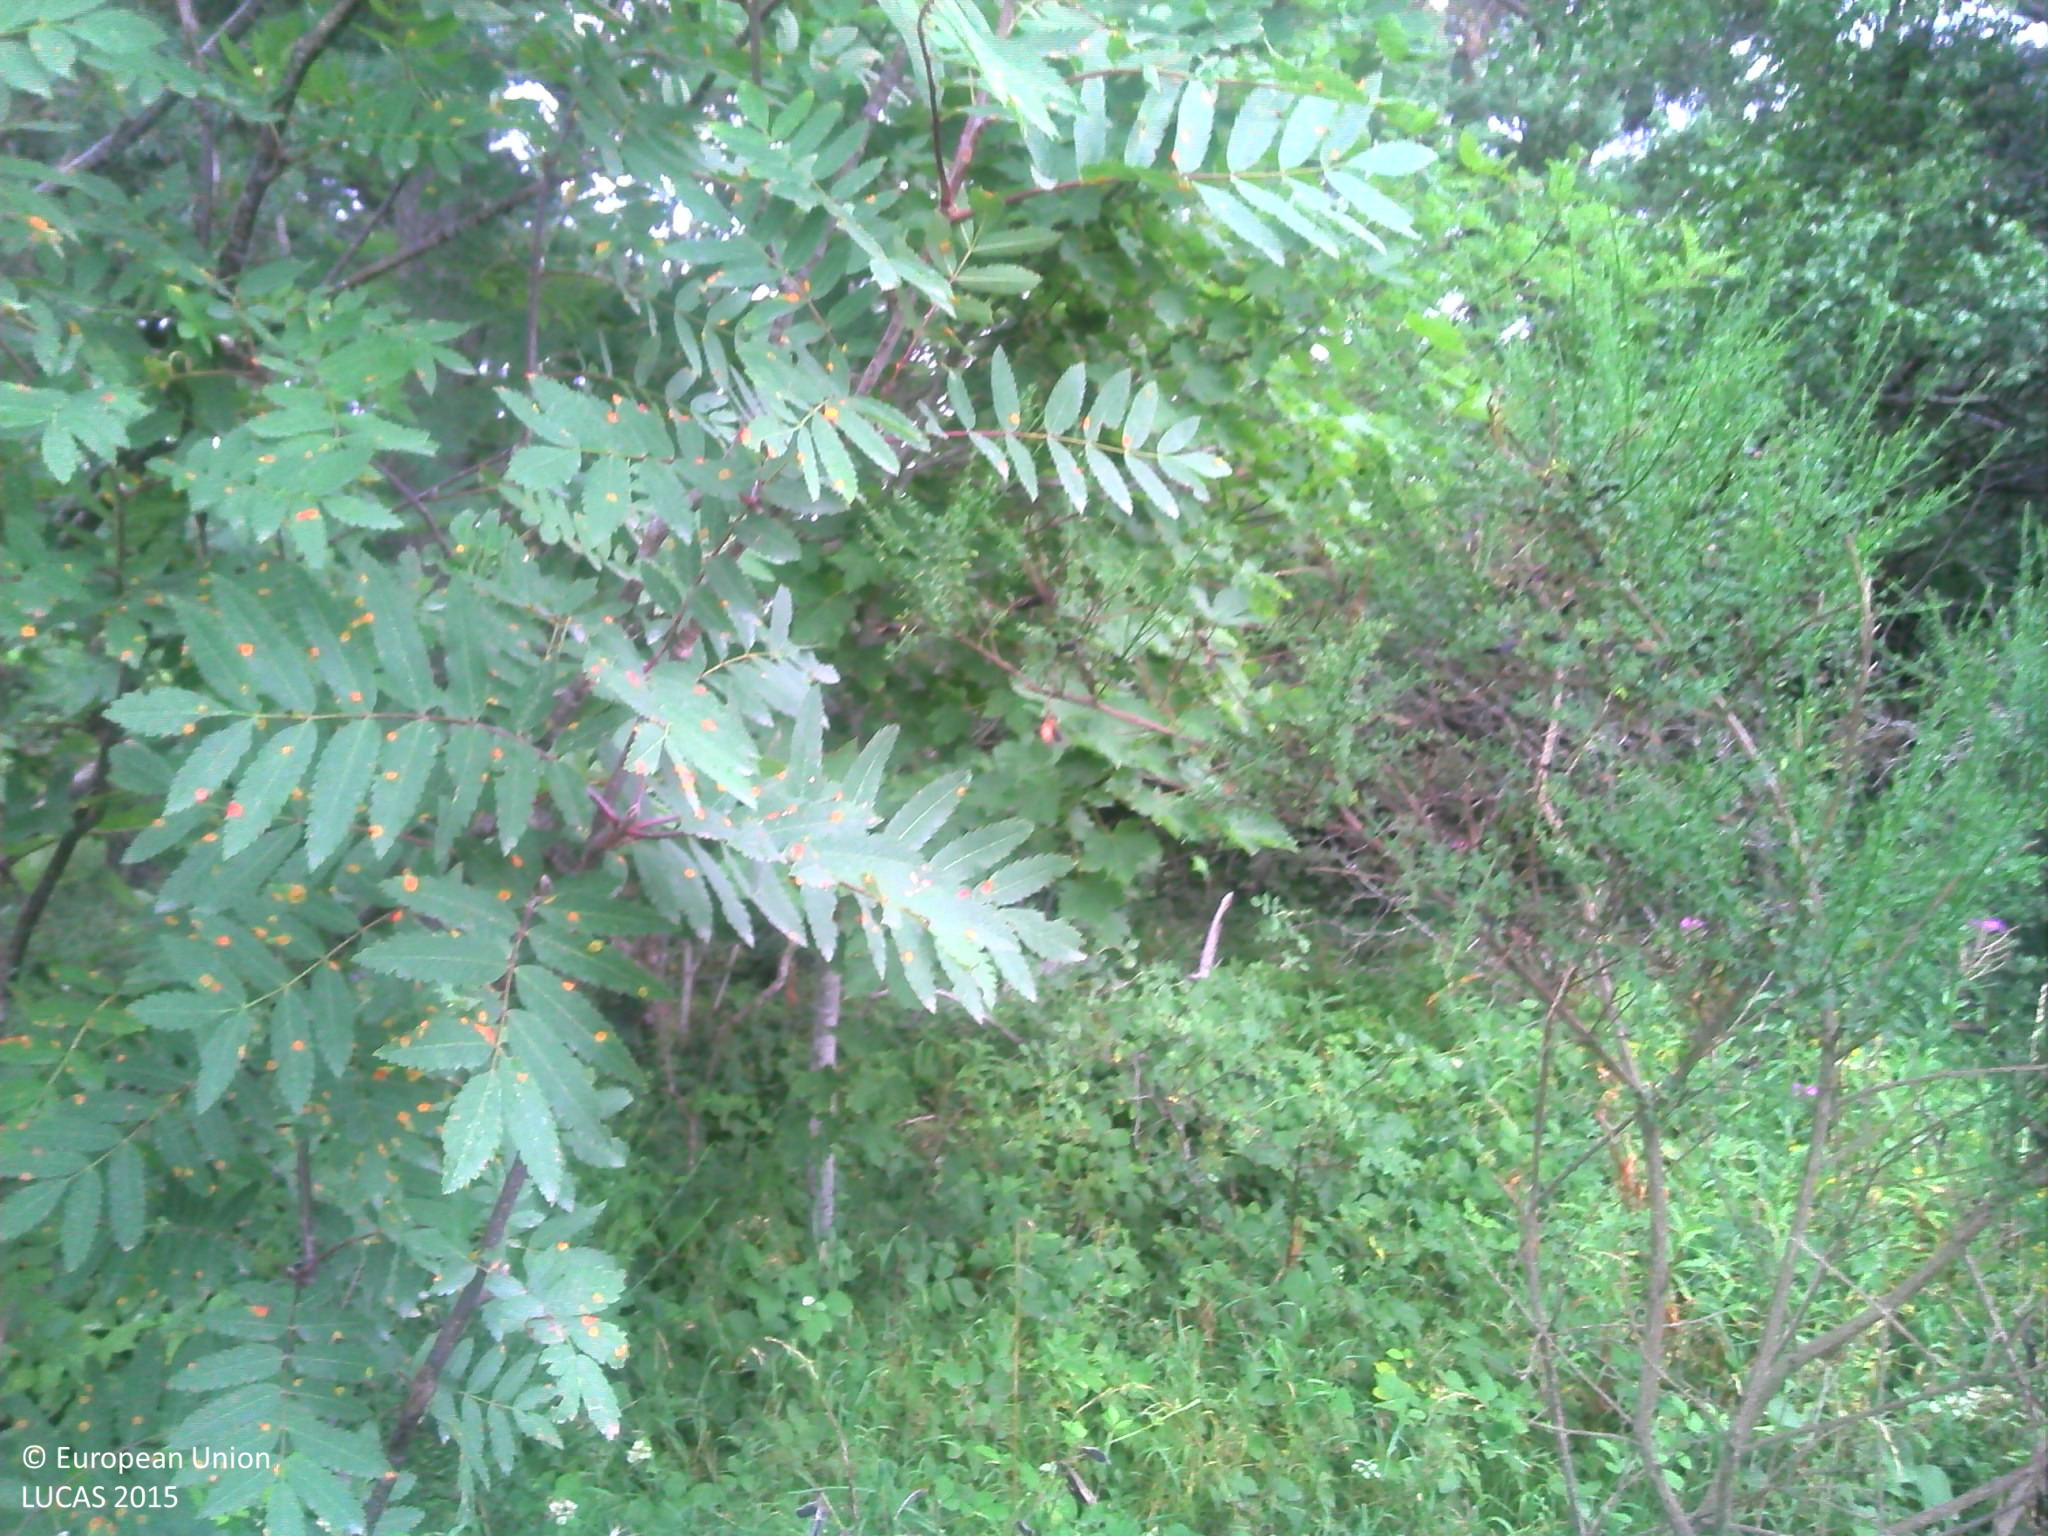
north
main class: Woodland
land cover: Pine dominated mixed woodland
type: mesophytic deciduous forest
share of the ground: > 75 %
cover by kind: broadleaved forest trees 45 %, coniferous forest trees 35 %, shrubs 10 %, herbaceous plants 10 %
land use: Forestry
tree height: < 5 m
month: August
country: FR
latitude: 45.0366
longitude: 4.1781
